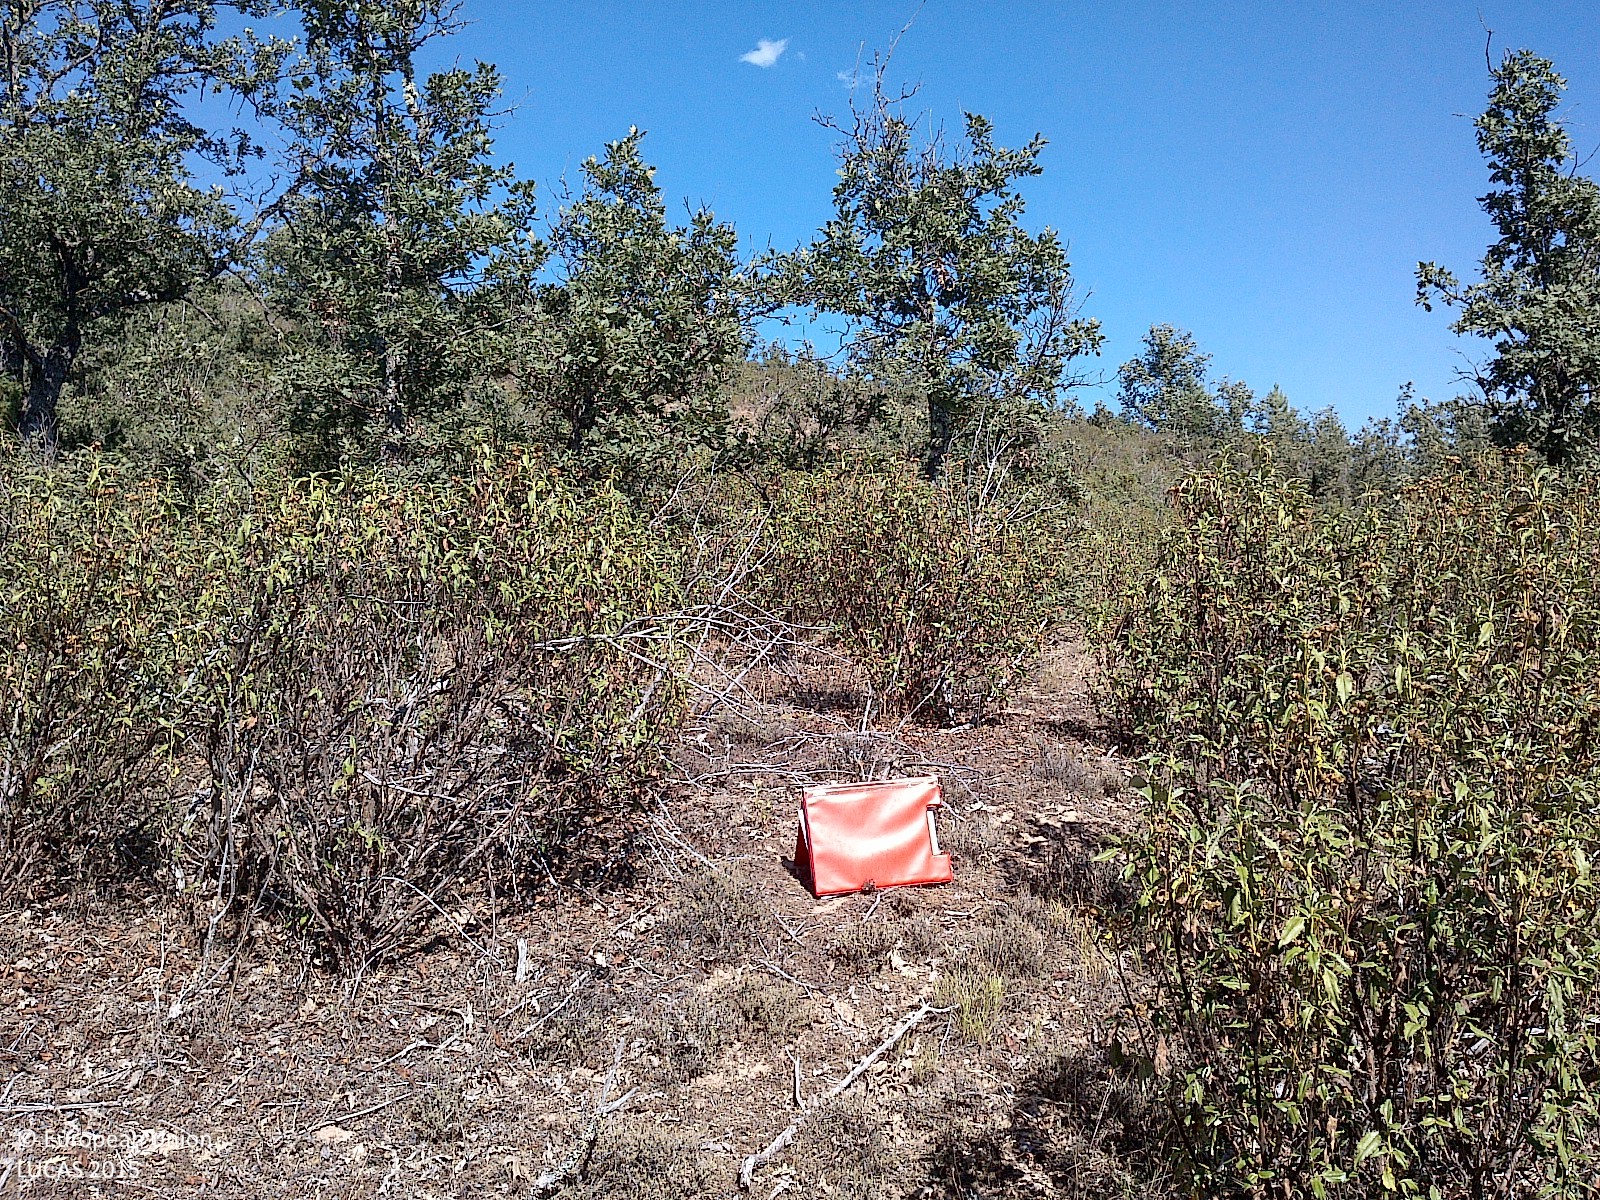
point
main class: Woodland
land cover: Broadleaved woodland
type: thermophilous deciduous forest
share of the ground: 10 - 25 %
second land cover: Grassland without tree/shrub cover
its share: 25 - 50 %
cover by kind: shrubs 55 %, herbaceous plants 25 %, broadleaved forest trees 20 %
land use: Forestry
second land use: Agriculture (excluding fallow land and kitchen gardens)
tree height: < 5 m
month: July
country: ES
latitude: 41.9218
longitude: -3.2775
